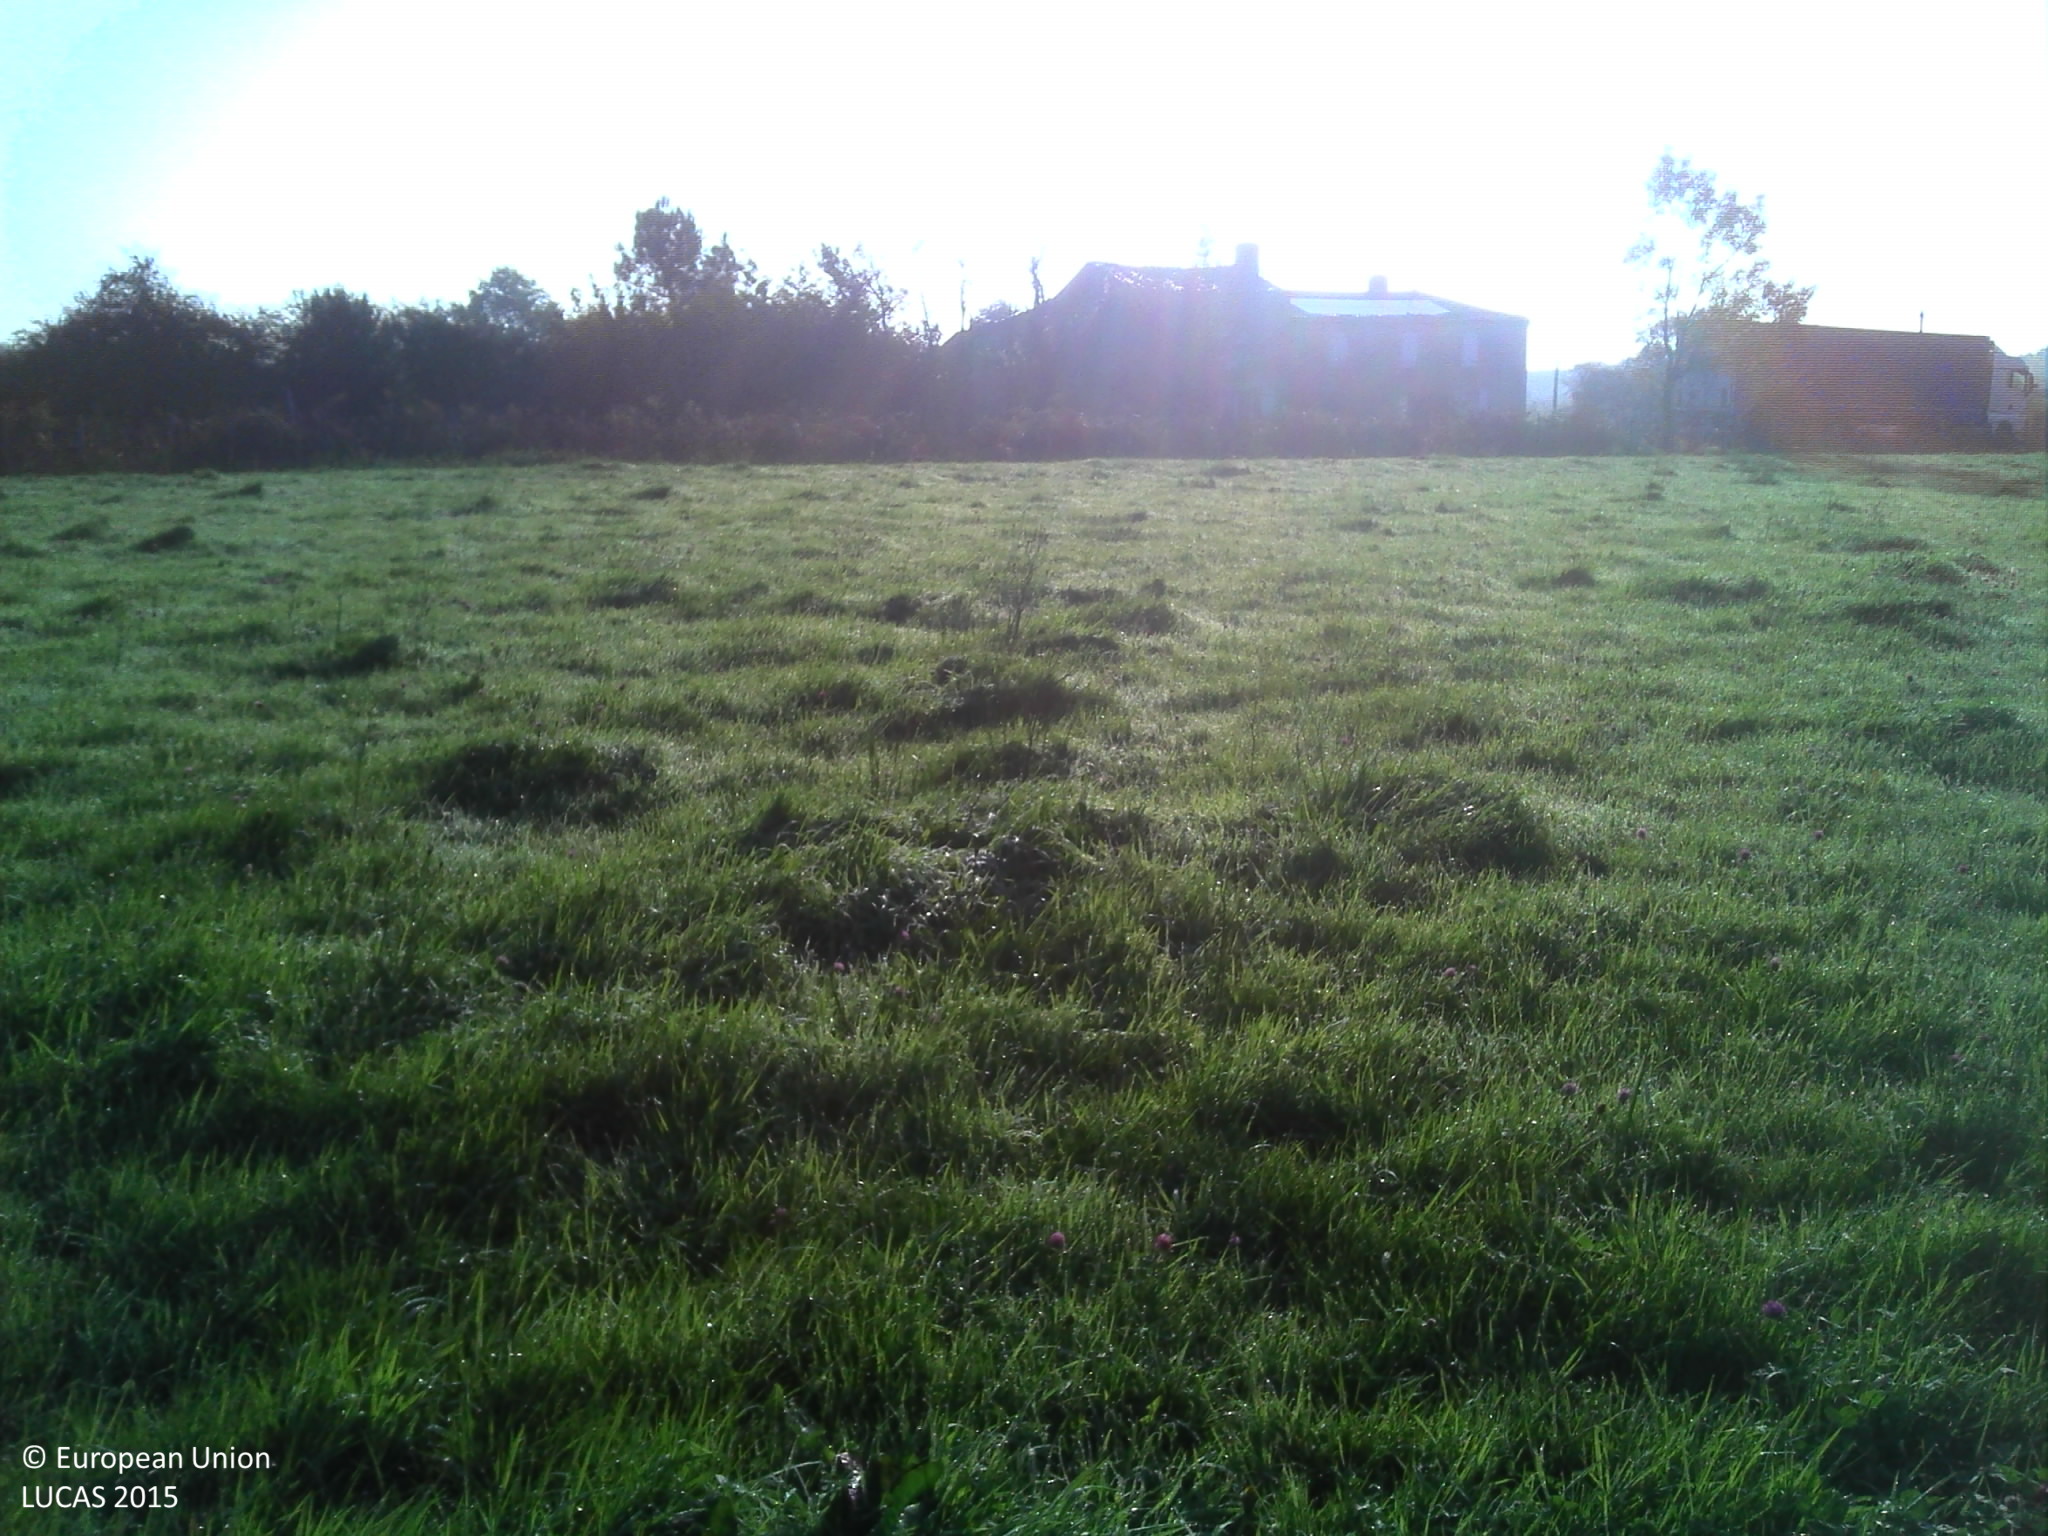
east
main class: Grassland
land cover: Grassland without tree/shrub cover
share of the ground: > 75 %
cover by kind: herbaceous plants 100 %
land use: Agriculture (excluding fallow land and kitchen gardens)
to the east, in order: Grassland without tree/shrub cover; Fences; Ditches and canals; Grass margins; Paved roads, cycling and walking lanes; Grass margins; Ditches and canals; Managed hedges; Spontaneously vegetated surfaces; Managed hedges; Maize; Ditches and canals; Grass margins; Paved roads, cycling and walking lanes; Grass margins; Ditches and canals; Electric lines; Managed hedges
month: October
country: FR
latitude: 46.6137
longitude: -1.0403
